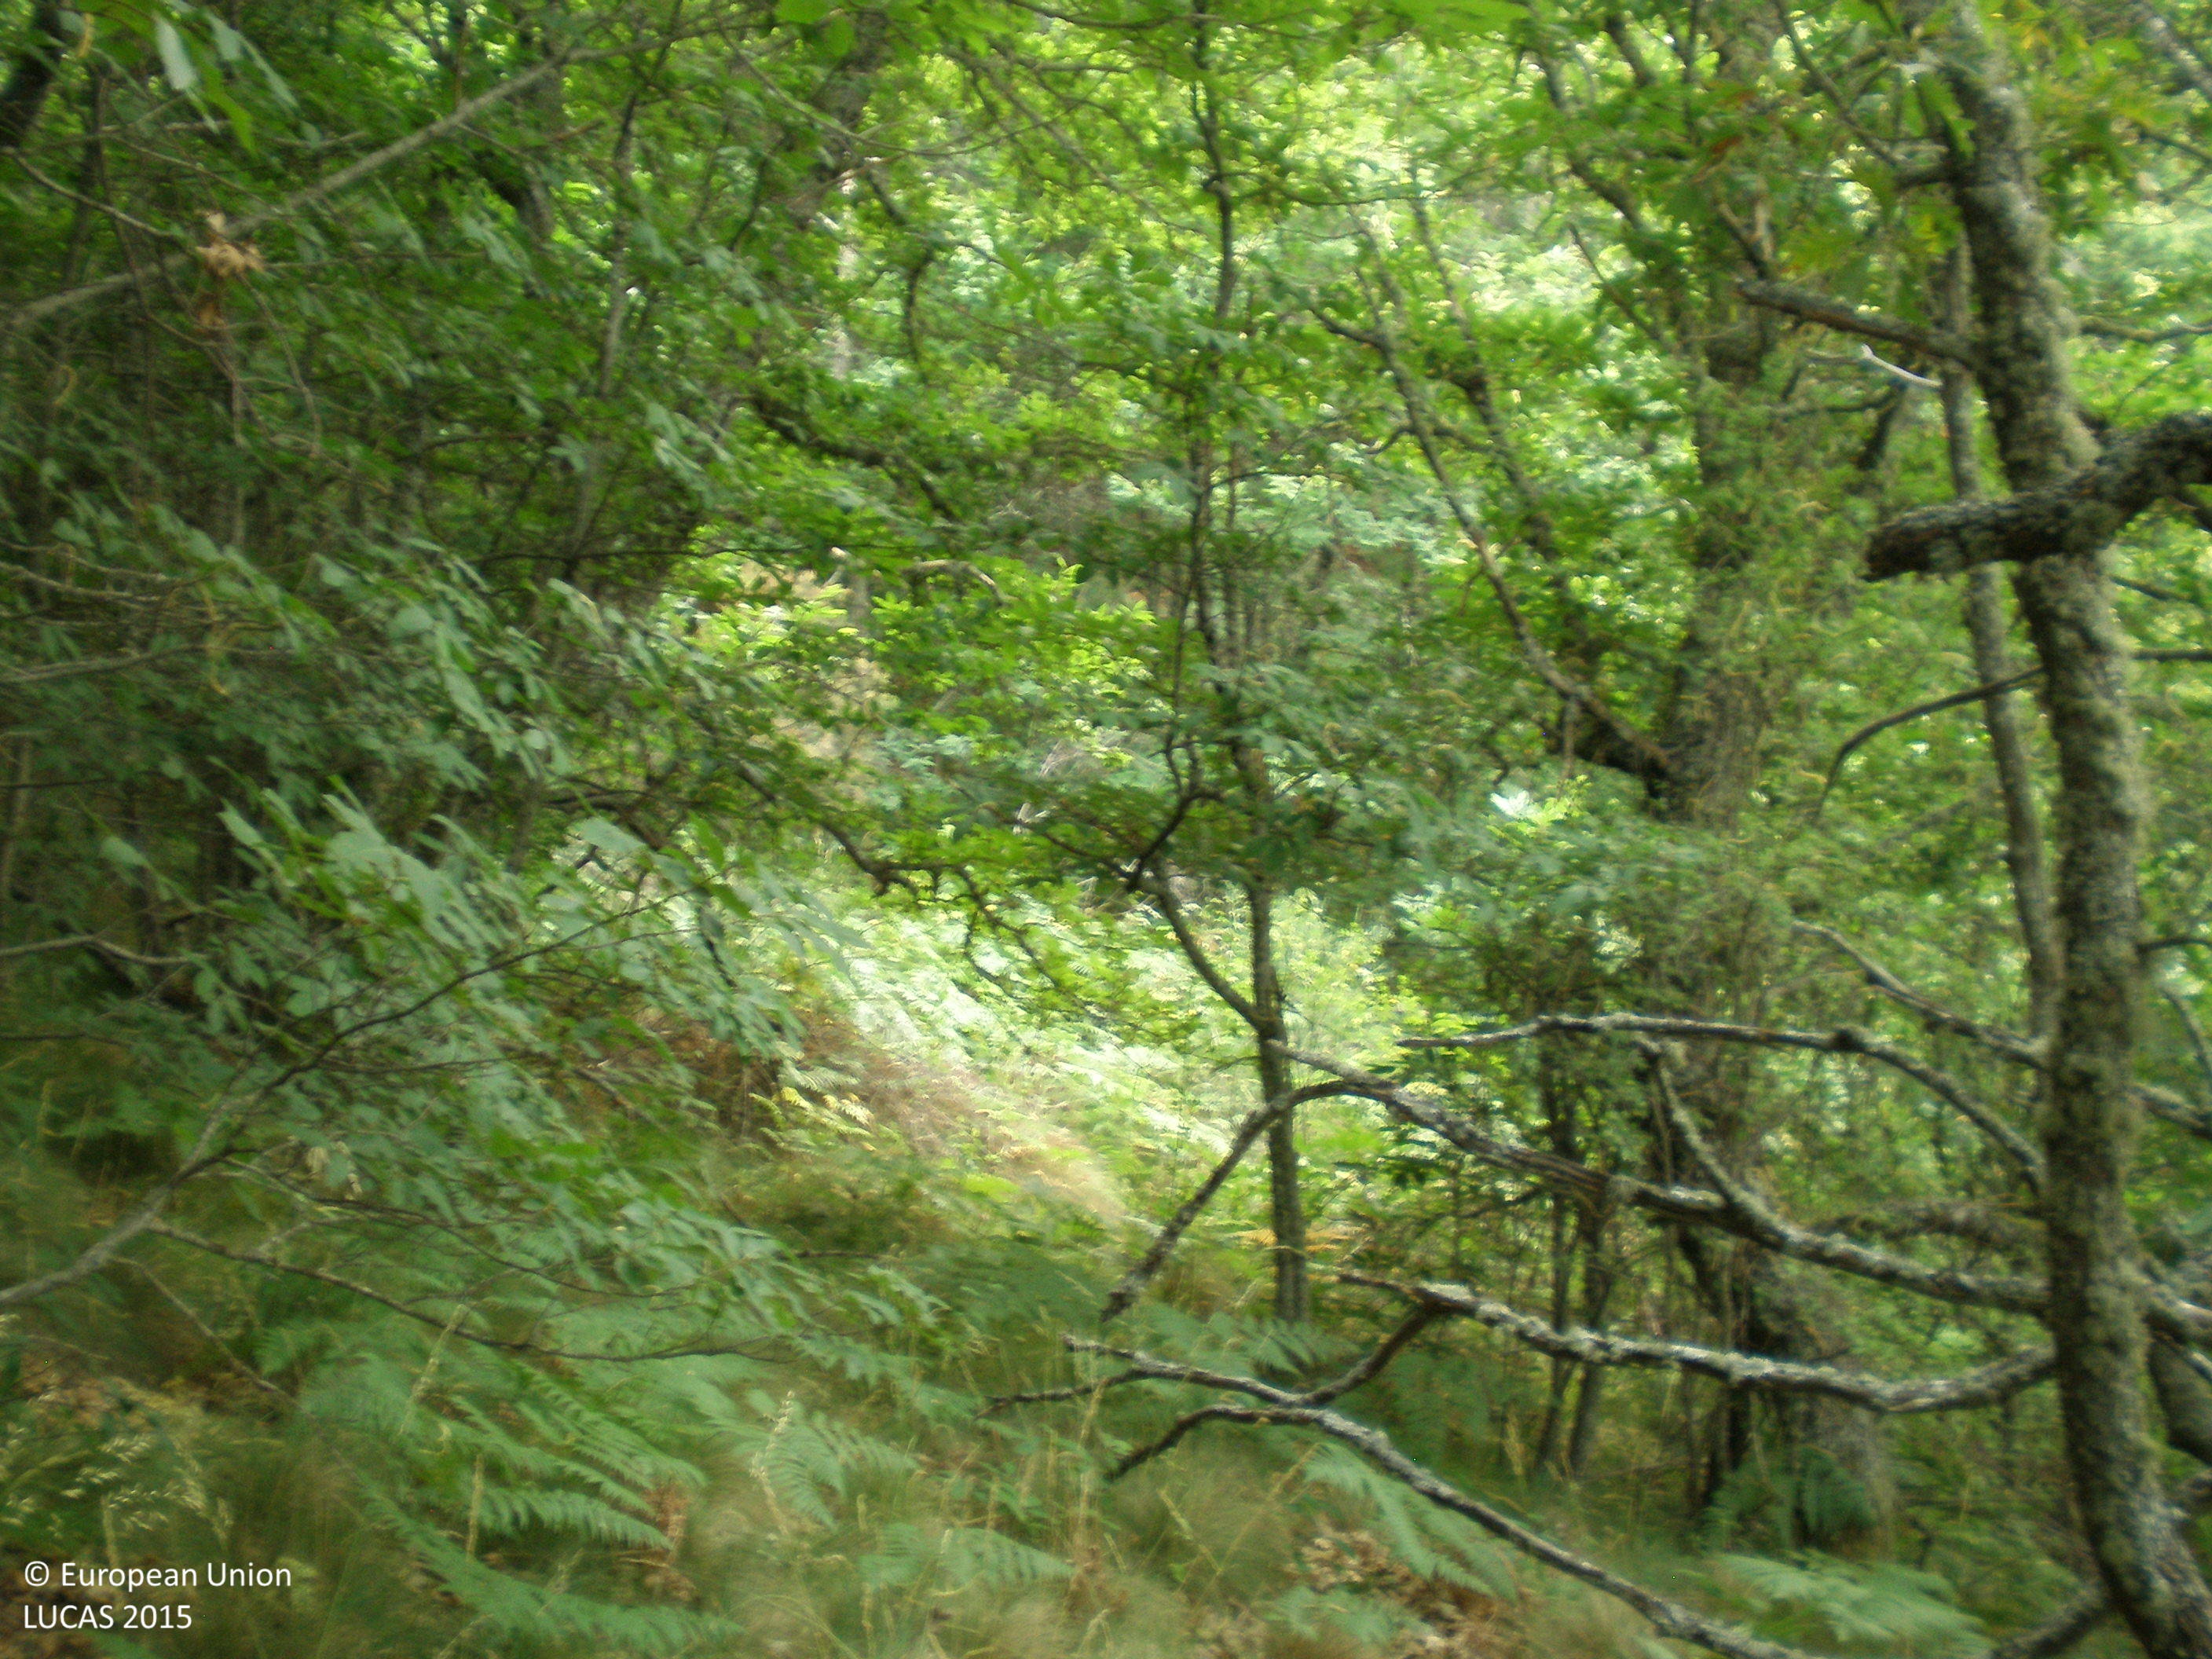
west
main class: Woodland
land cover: Broadleaved woodland
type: thermophilous deciduous forest
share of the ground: > 75 %
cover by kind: broadleaved forest trees 100 %
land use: Forestry
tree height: > 5 m
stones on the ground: < 10 %
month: July
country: ES
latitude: 40.3802
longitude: -5.7719
